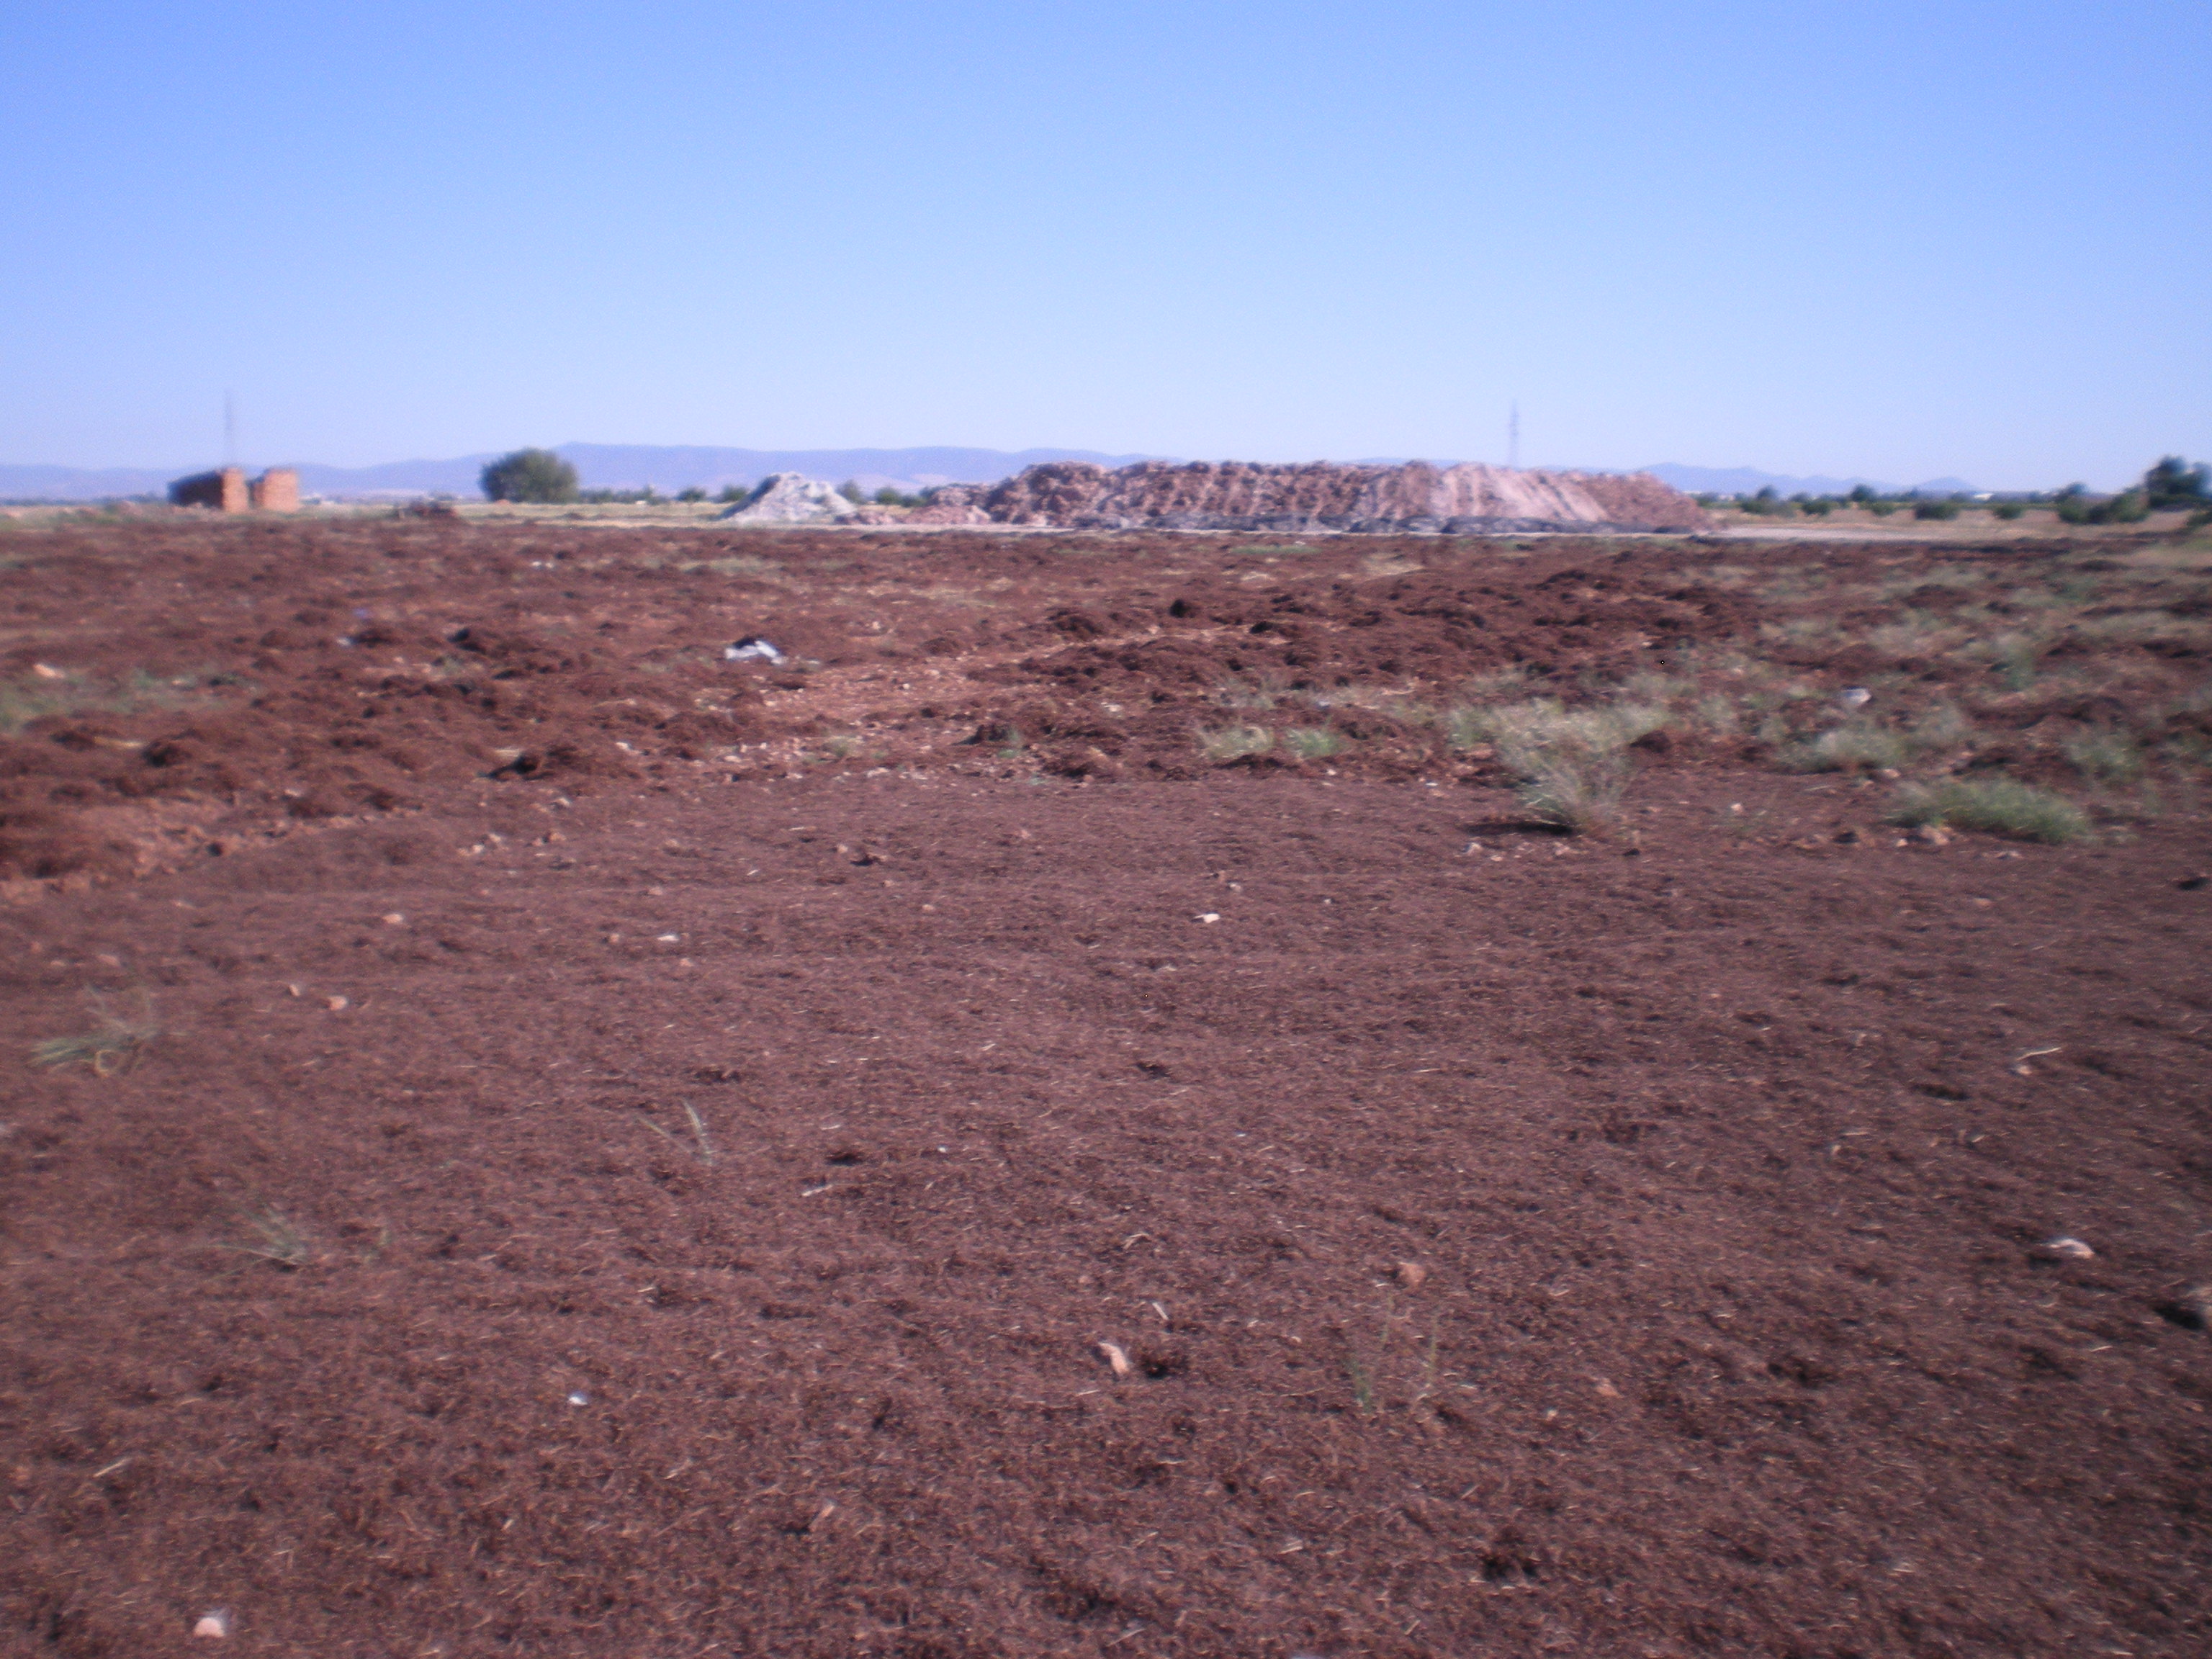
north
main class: Grassland
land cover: Spontaneously vegetated surfaces
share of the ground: 10 - 25 %
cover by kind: unconsolidated bare surface 85 %, herbaceous plants 15 %
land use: Agriculture (excluding fallow land and kitchen gardens)
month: May
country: ES
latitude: 39.0238
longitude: -3.5889
